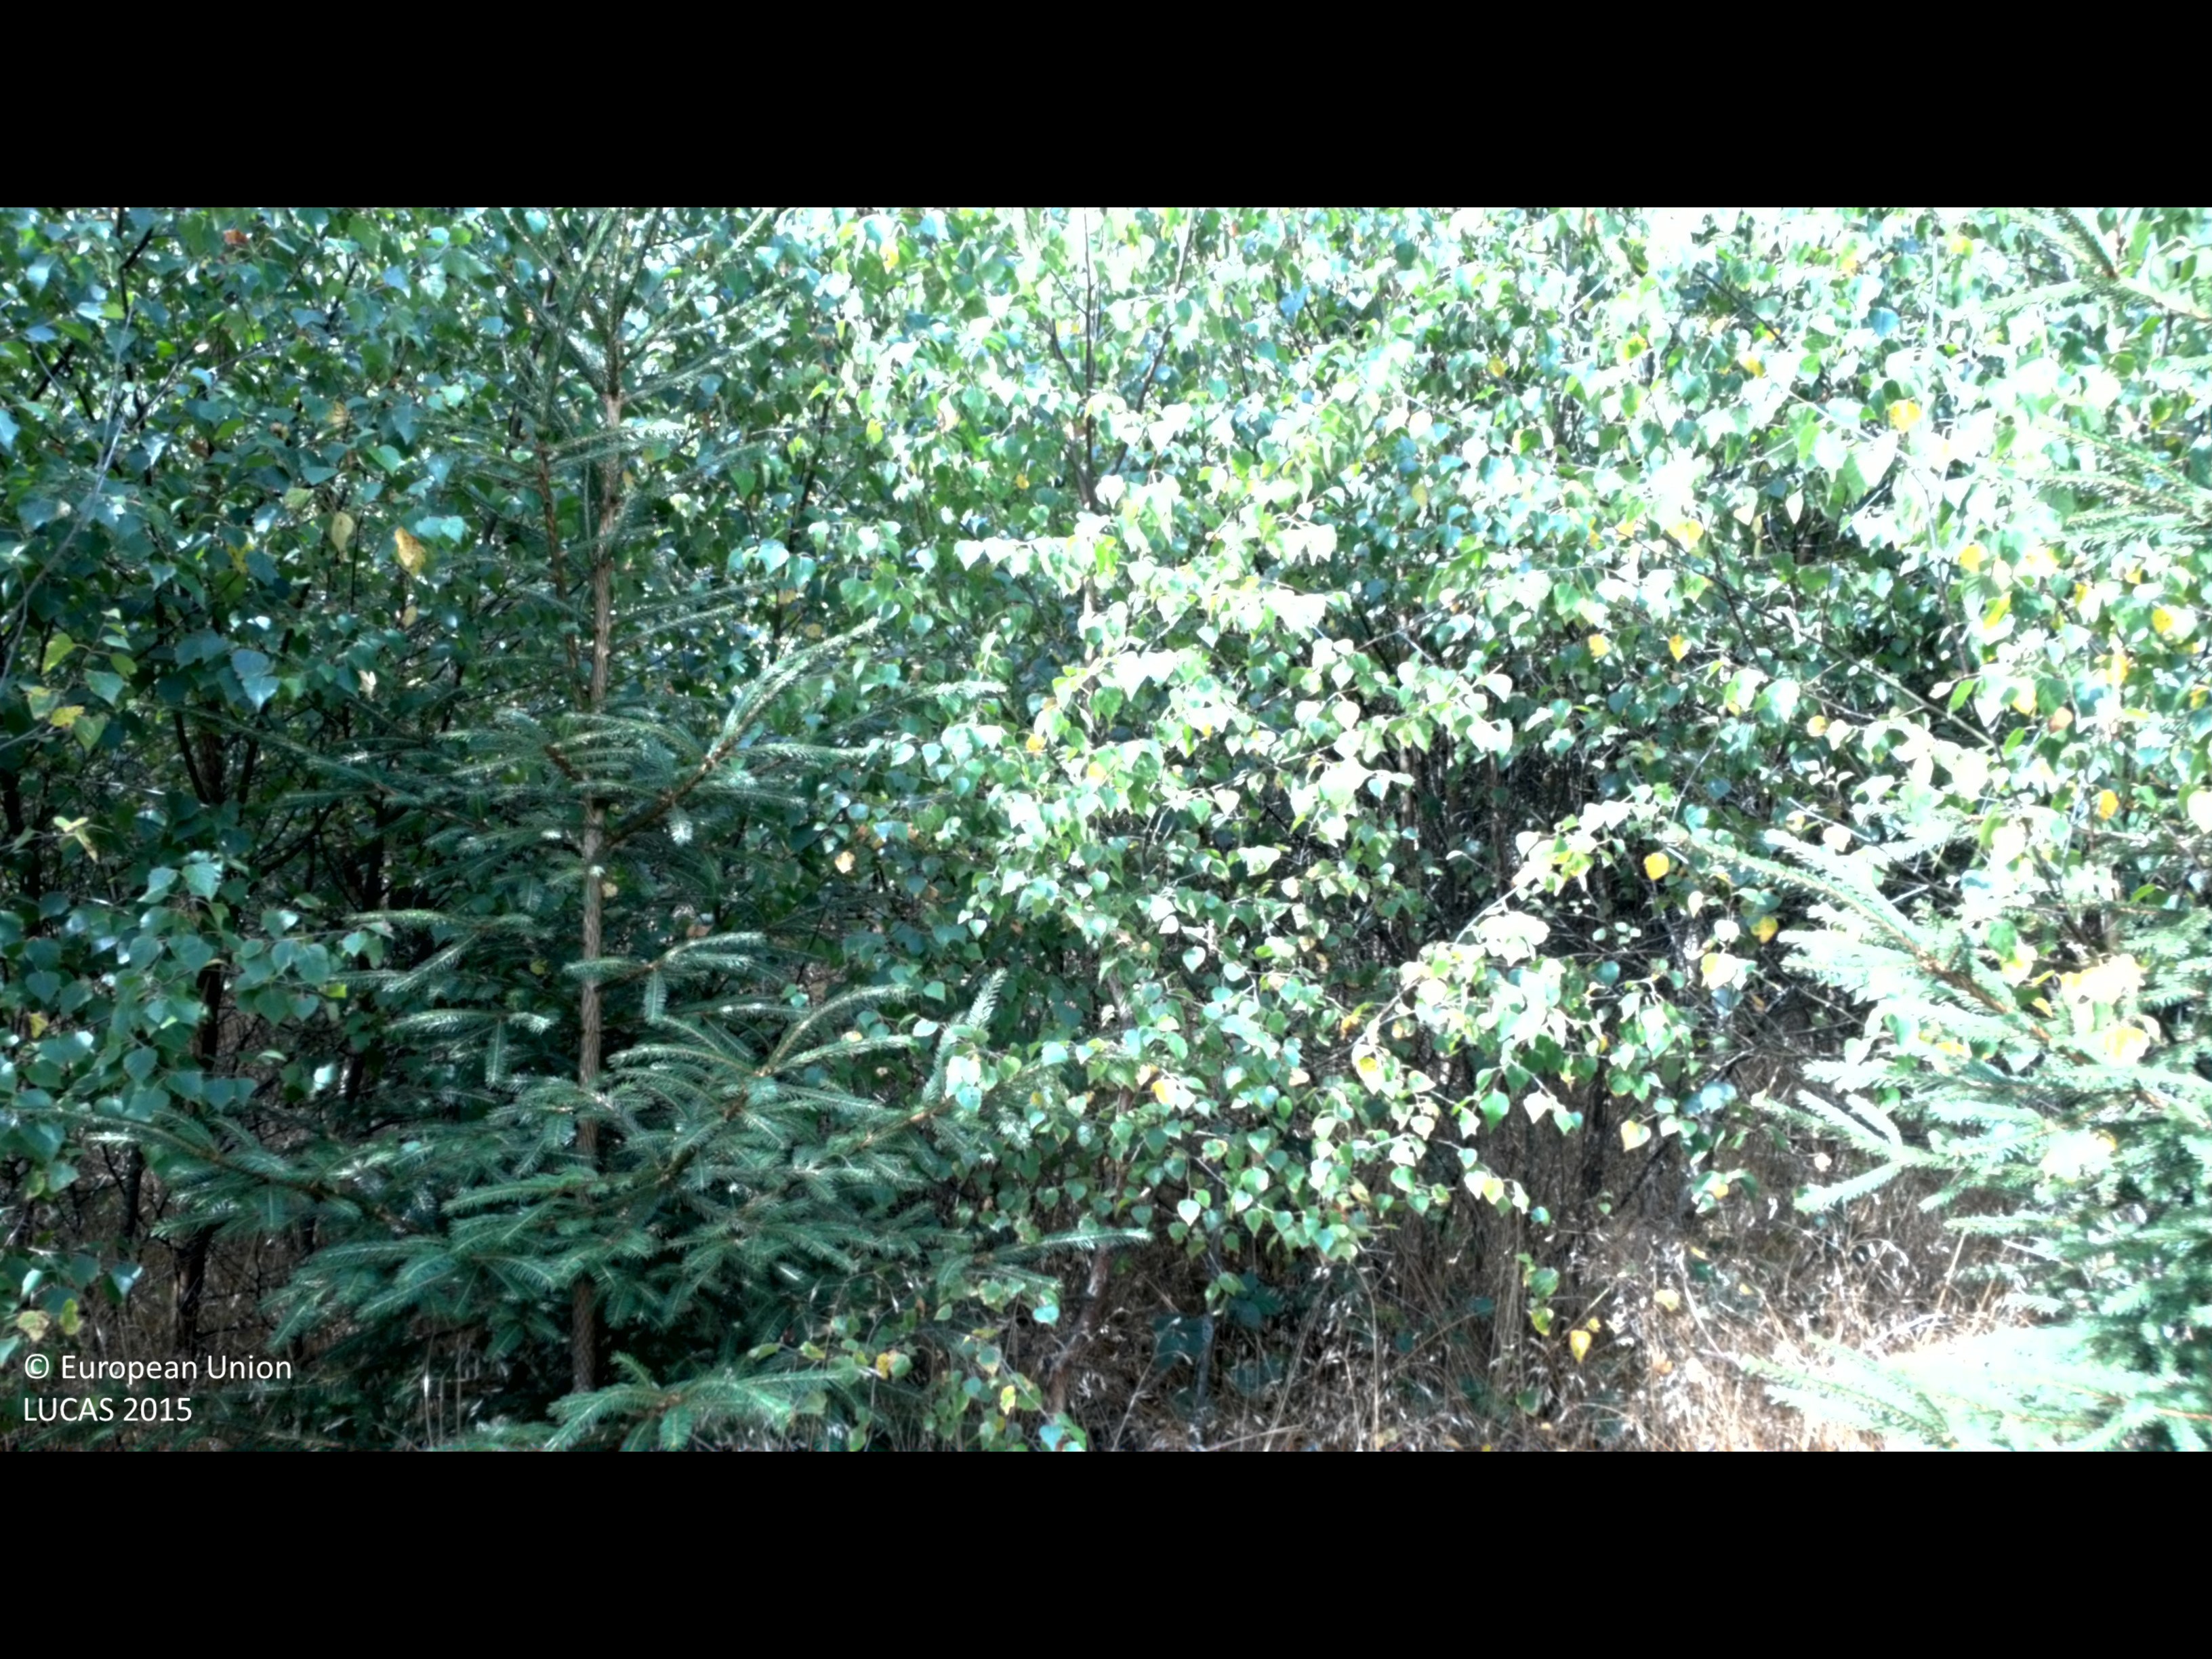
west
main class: Woodland
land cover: Broadleaved woodland
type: boreal forest
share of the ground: 50 - 75 %
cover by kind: broadleaved forest trees 65 %, herbaceous plants 25 %, coniferous forest trees 5 %, shrubs 5 %
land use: Forestry
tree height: < 5 m
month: August
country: SE
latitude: 56.2702
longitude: 15.8620
